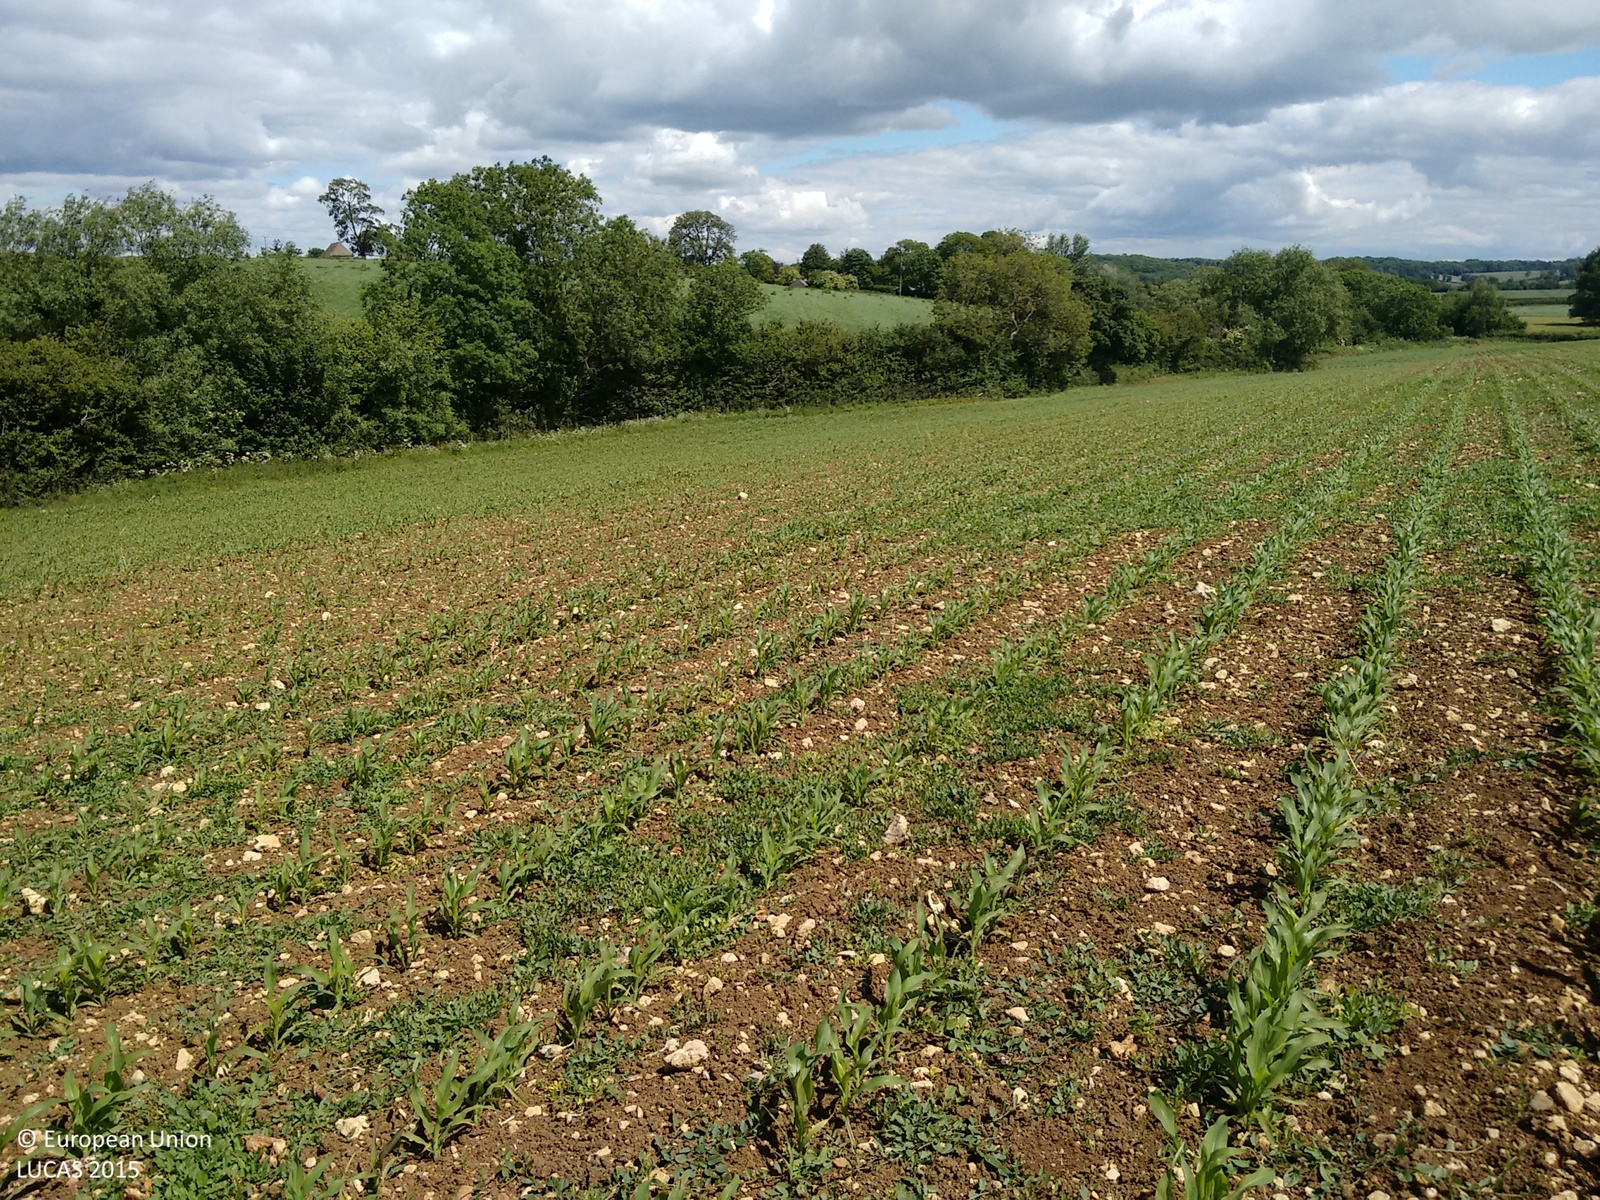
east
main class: Cropland
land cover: Maize
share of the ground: 10 - 25 %
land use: Agriculture (excluding fallow land and kitchen gardens)
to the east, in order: Maize; Spontaneously vegetated surfaces; Fences; Broadleaved woodland; Rivers and streams; Broadleaved woodland; Fences; Grassland without tree/shrub cover
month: June
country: GB
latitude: 51.2717
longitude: -2.3771
